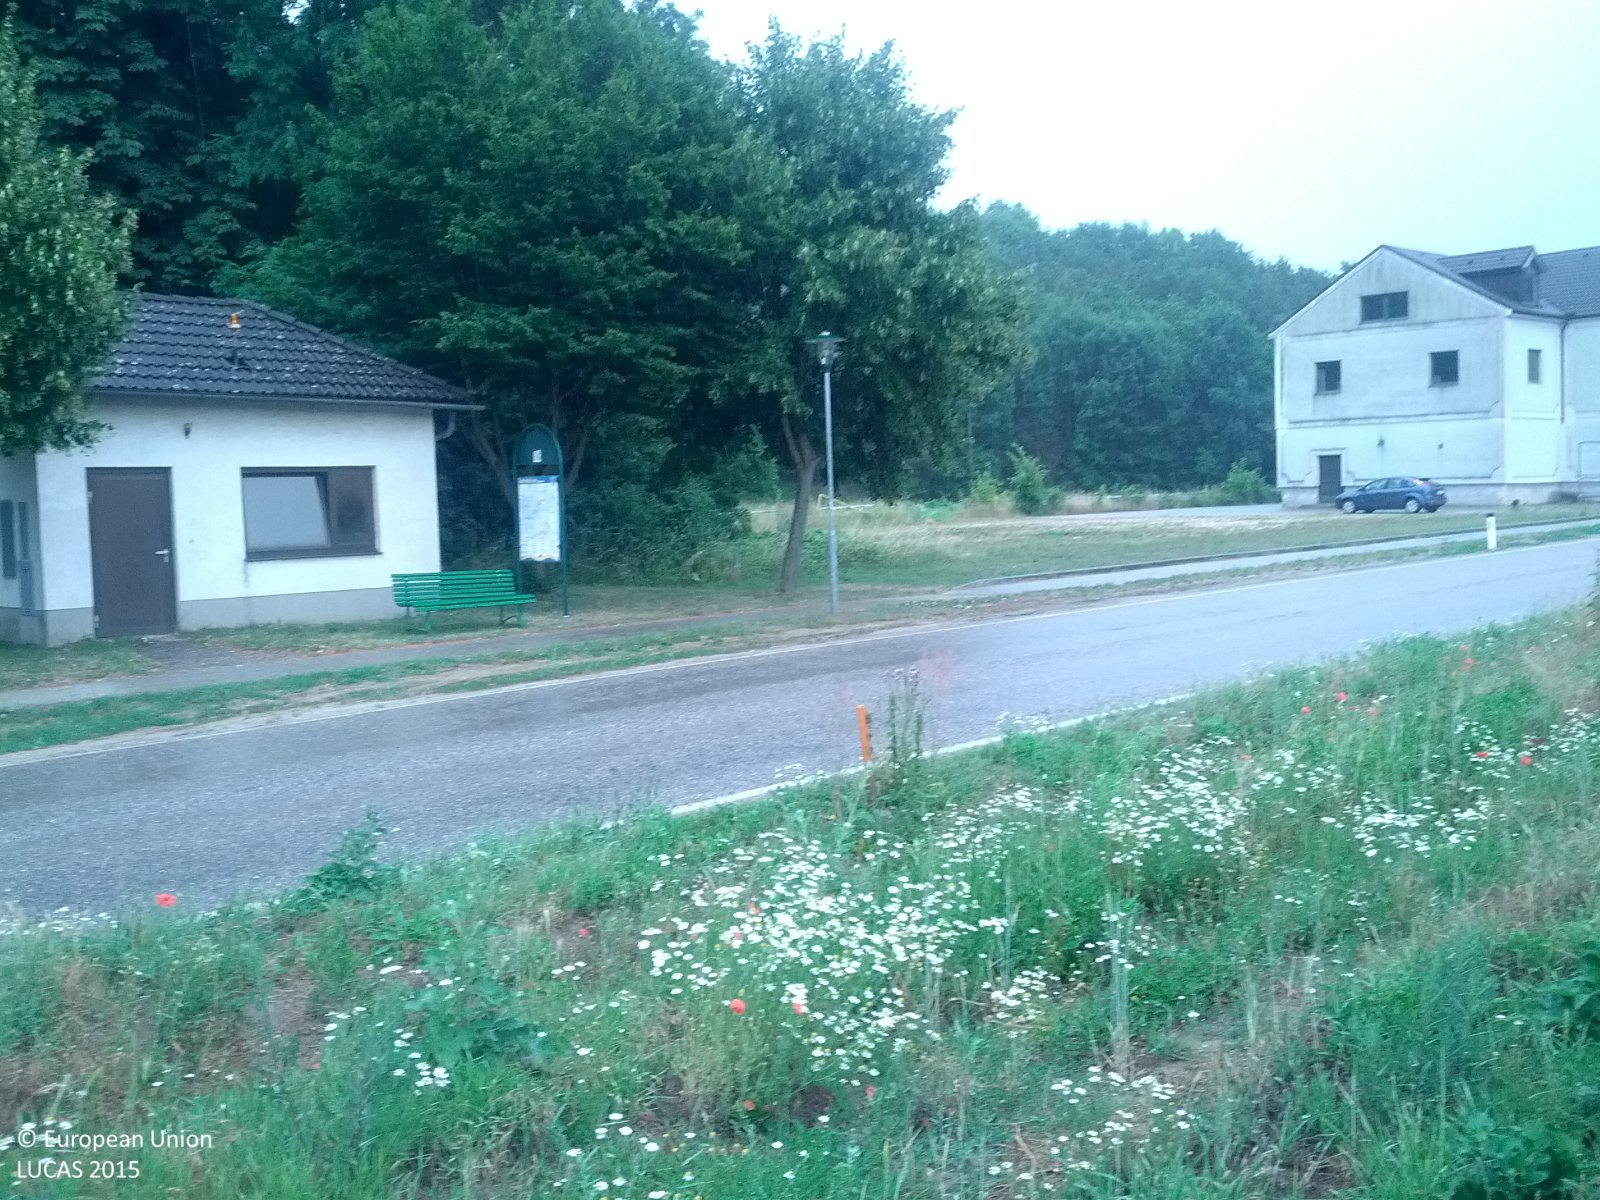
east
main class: Cropland
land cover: Rape and turnip rape
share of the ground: > 75 %
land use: Agriculture (excluding fallow land and kitchen gardens)
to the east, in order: Rape and turnip rape; Grassland without tree/shrub cover; Ditches and canals; Grass margins; Paved roads, cycling and walking lanes; Grass margins; Tracks; Broadleaved woodland; Rivers and streams; Broadleaved woodland; Grassland without tree/shrub cover; Other mixed woodland; Tracks; Grass margins; Vineyards
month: July
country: AT
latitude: 48.7492
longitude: 16.5758
